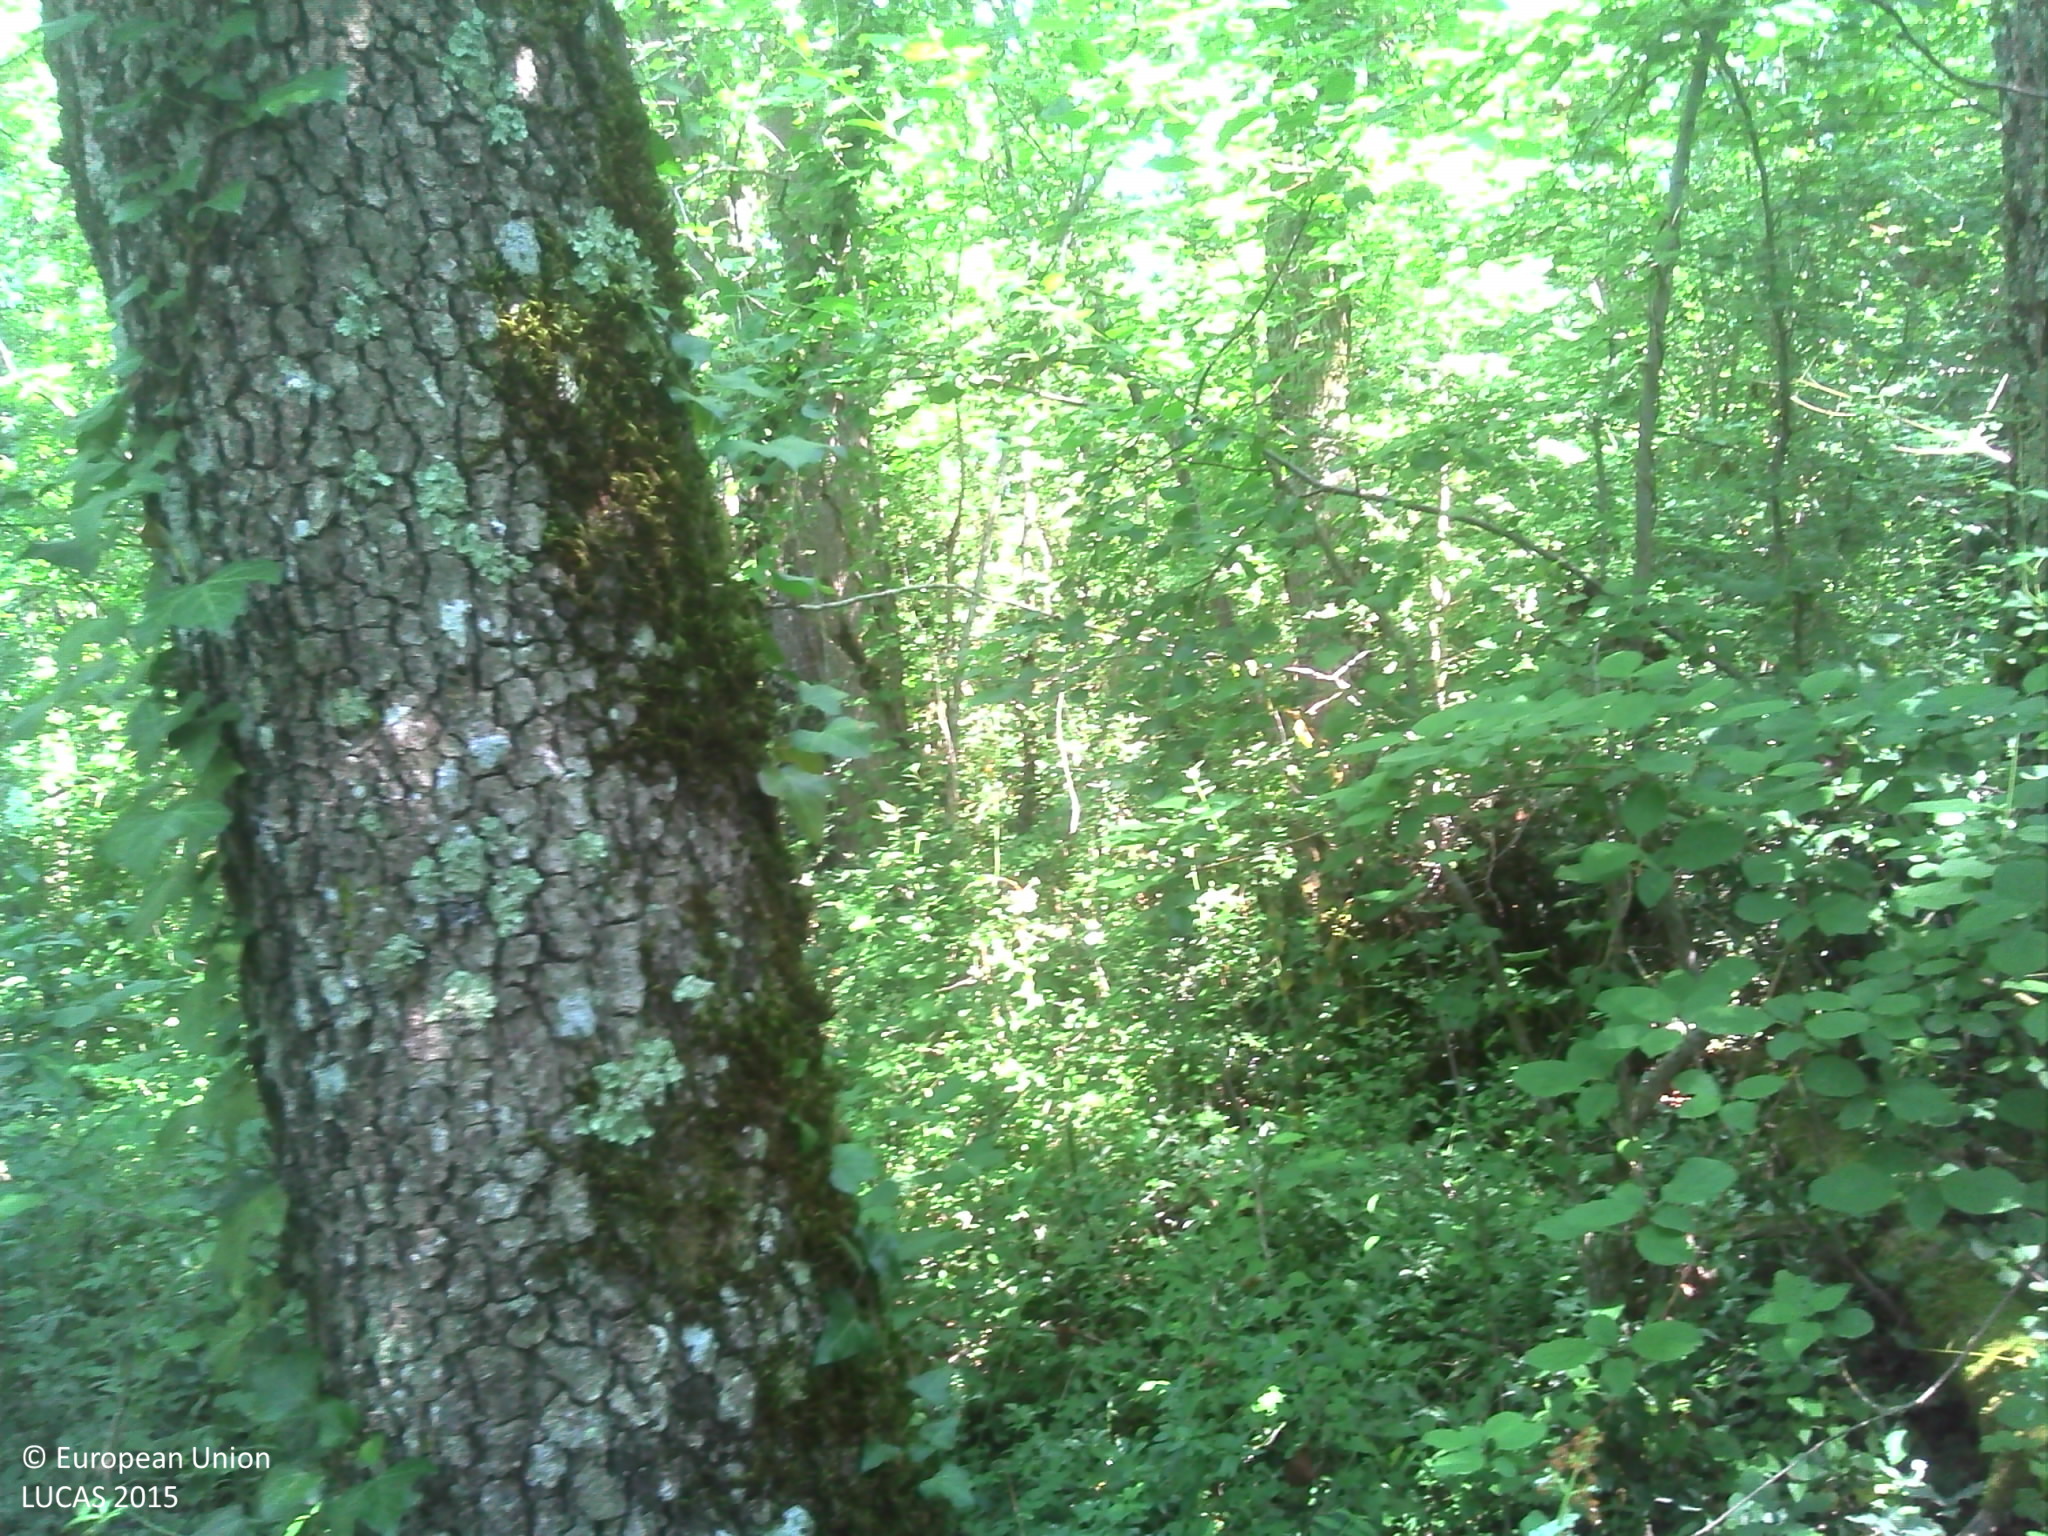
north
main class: Woodland
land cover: Broadleaved woodland
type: mesophytic deciduous forest
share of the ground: > 75 %
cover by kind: broadleaved forest trees 100 %
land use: Forestry
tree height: > 5 m
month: June
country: FR
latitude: 43.8566
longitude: 1.9542
